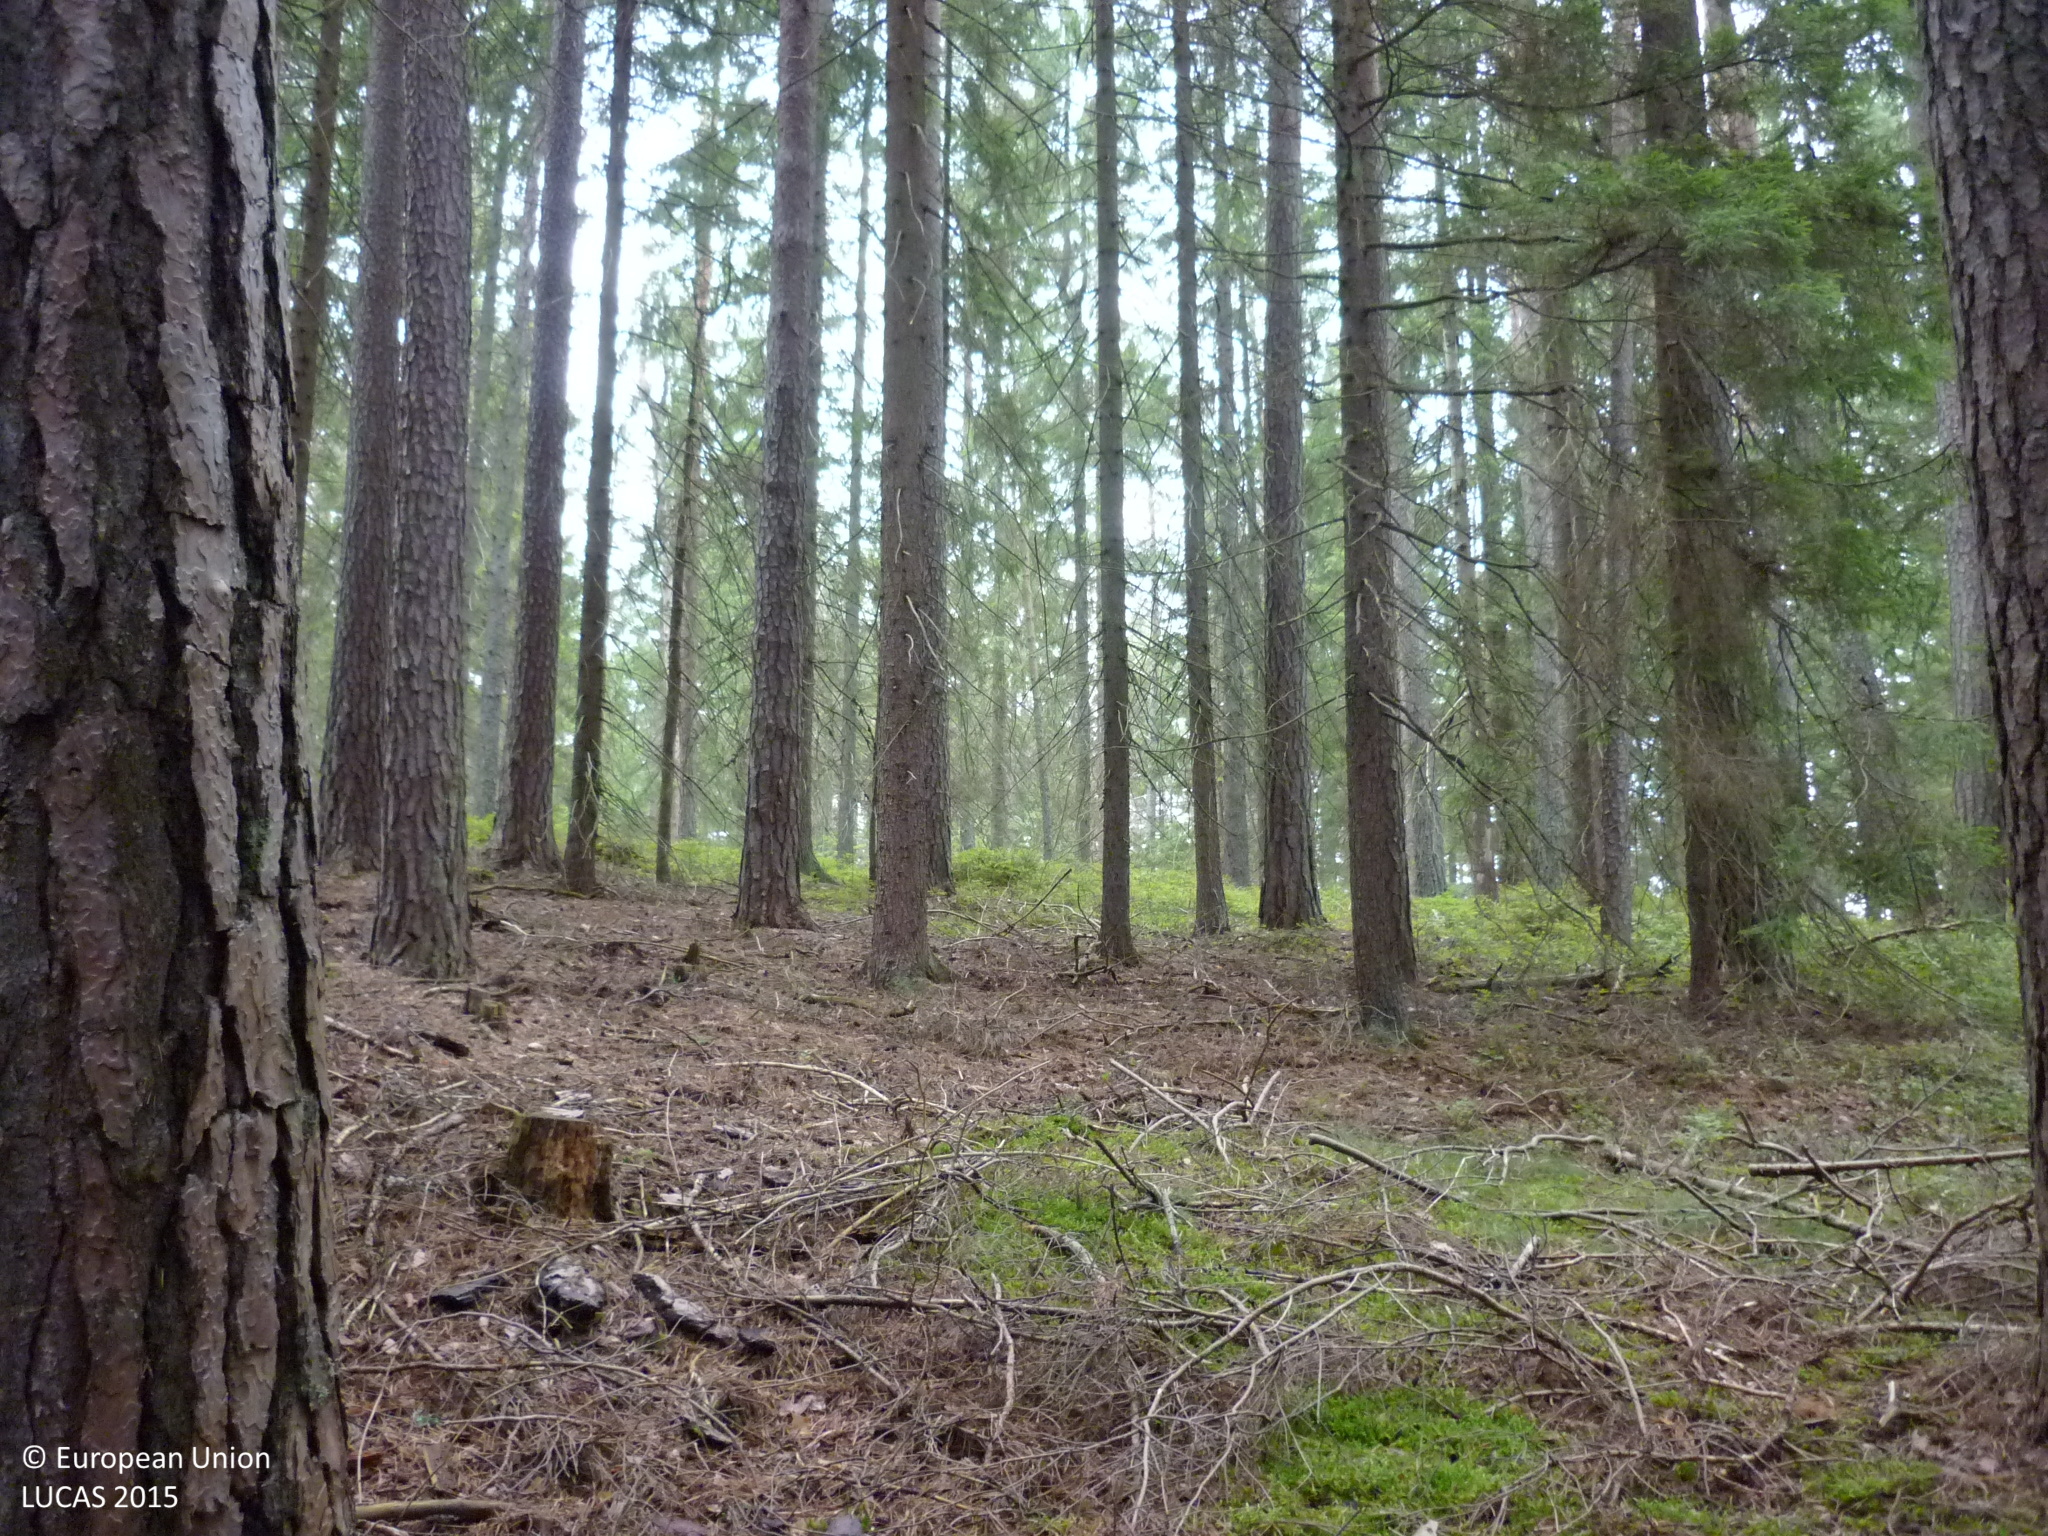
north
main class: Woodland
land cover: Spruce dominated coniferous woodland
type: hemiboreal forest and nemoral coniferous forest and mixed broadleaved-coniferous forest
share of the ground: > 75 %
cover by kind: coniferous forest trees 100 %
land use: Forestry
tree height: > 5 m
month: September
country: AT
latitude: 48.9196
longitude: 15.0378
